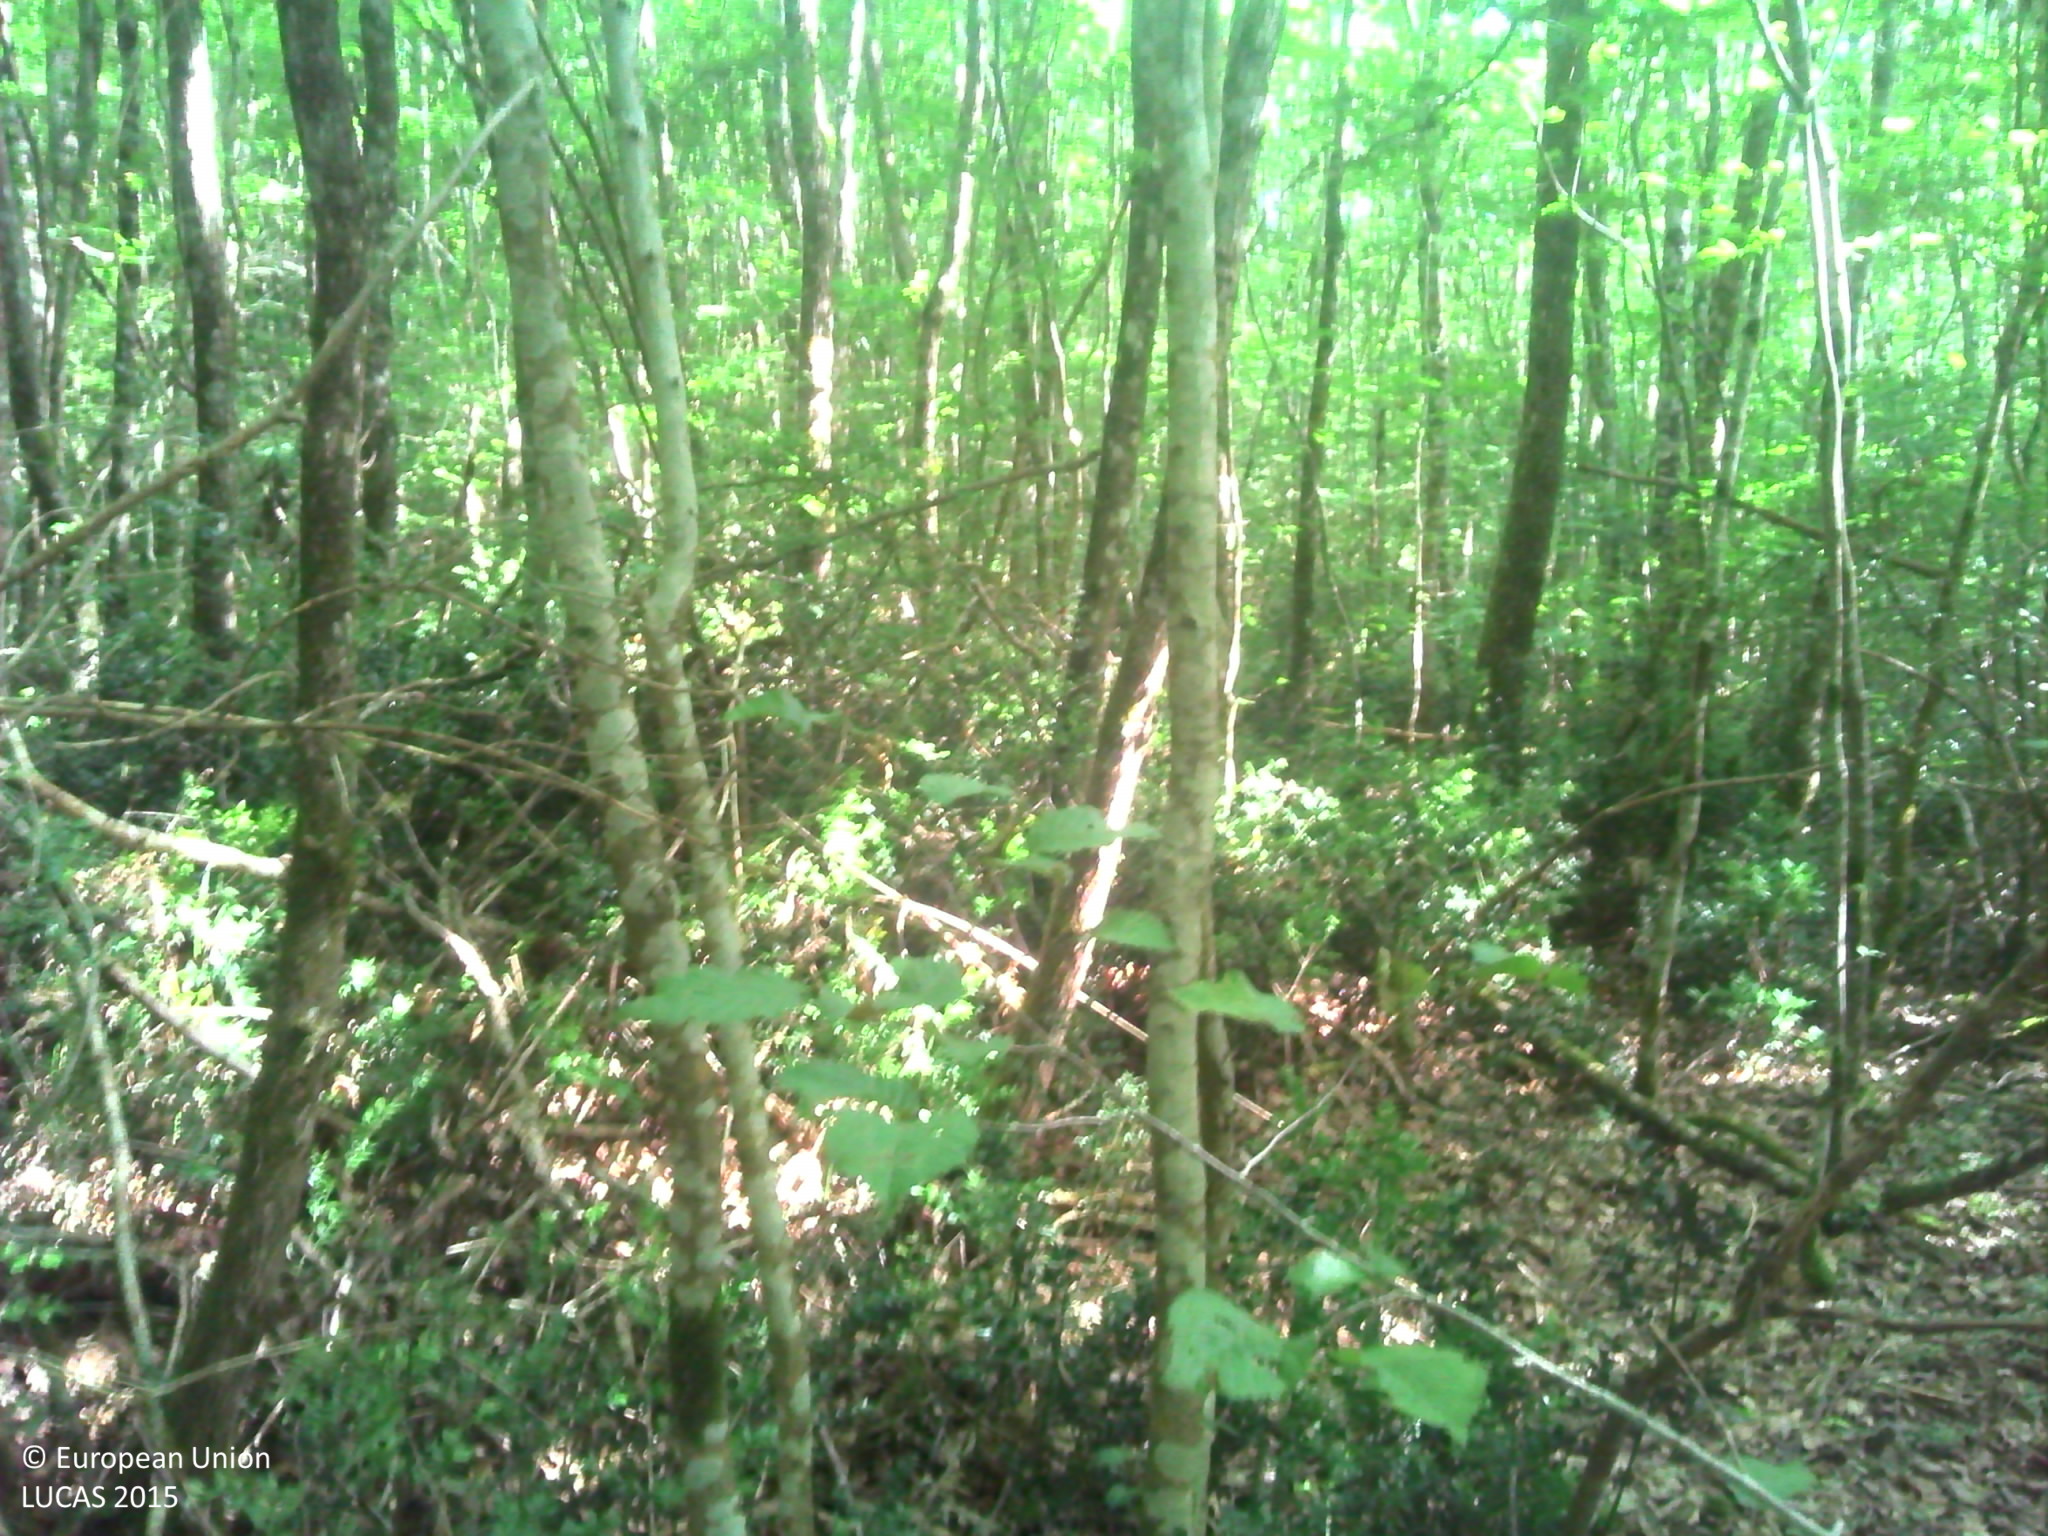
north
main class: Woodland
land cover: Broadleaved woodland
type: mesophytic deciduous forest
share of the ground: > 75 %
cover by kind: unconsolidated bare surface 50 %, herbaceous plants 30 %, broadleaved forest trees 20 %
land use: Forestry
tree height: > 5 m
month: June
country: FR
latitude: 47.5224
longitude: 1.3659
